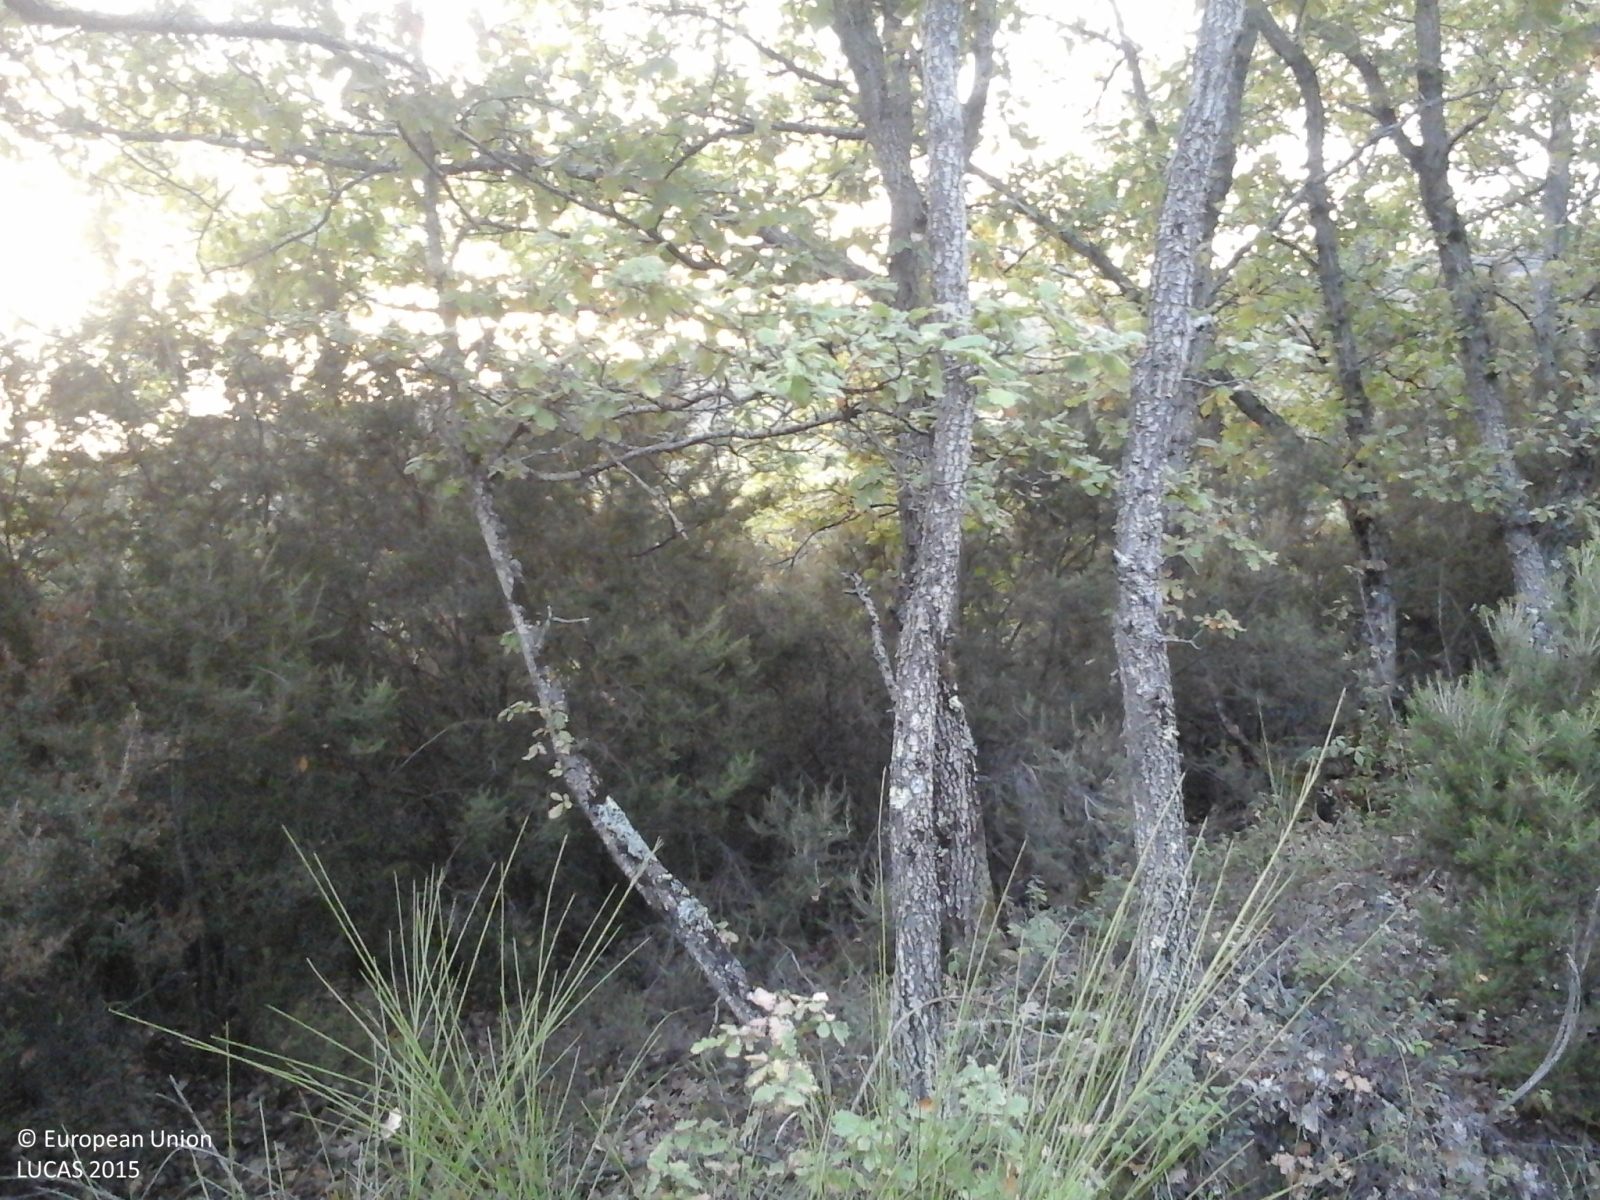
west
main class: Woodland
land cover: Broadleaved woodland
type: thermophilous deciduous forest
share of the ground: > 75 %
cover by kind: broadleaved forest trees 95 %, shrubs 5 %
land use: Semi-natural and natural areas not in use
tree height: > 5 m
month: October
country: IT
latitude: 43.3732
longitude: 12.0800
